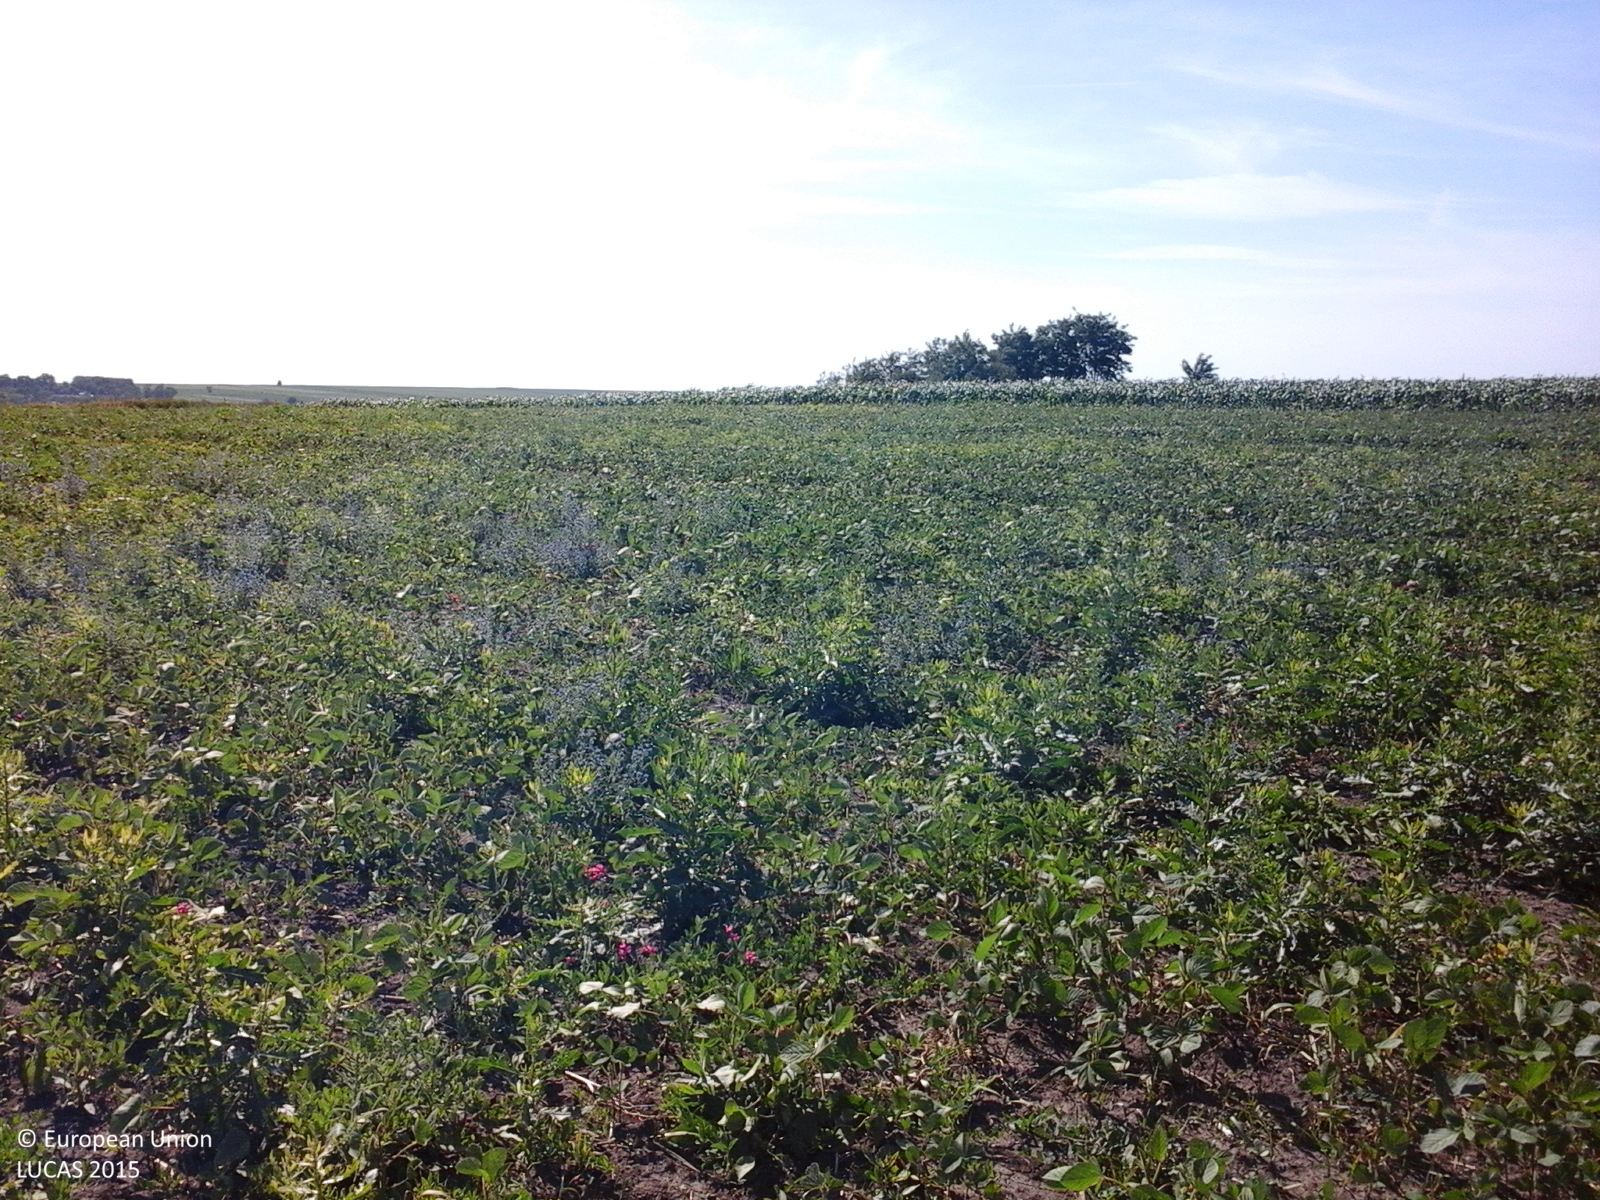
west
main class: Cropland
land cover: Soya
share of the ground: > 75 %
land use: Agriculture (excluding fallow land and kitchen gardens)
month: June
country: RO
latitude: 48.0747
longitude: 26.9499
